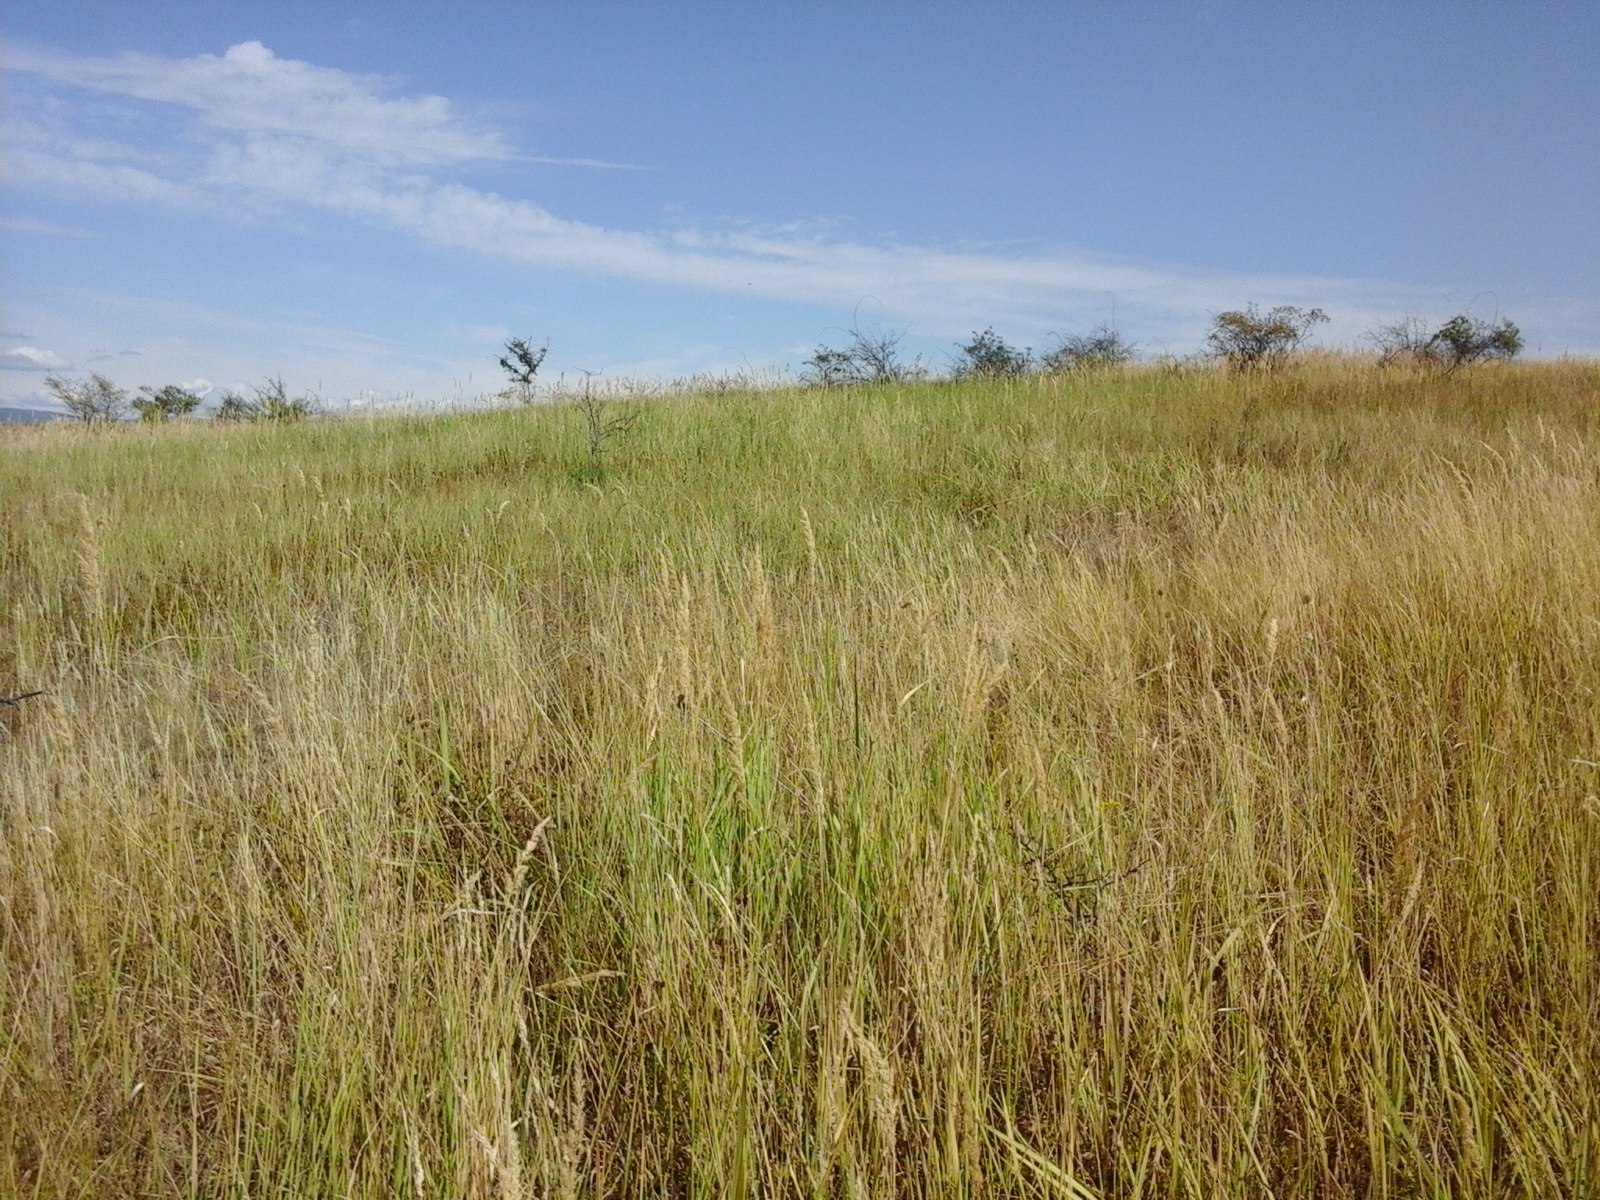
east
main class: Grassland
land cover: Grassland with sparse tree/shrub cover
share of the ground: > 75 %
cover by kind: herbaceous plants 95 %, broadleaved forest trees 5 %
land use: Agriculture (excluding fallow land and kitchen gardens)
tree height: < 5 m
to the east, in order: Grassland with sparse tree/shrub cover; Tracks; Lucerne; Grassland without tree/shrub cover
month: August
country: RO
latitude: 45.2039
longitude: 21.4754
